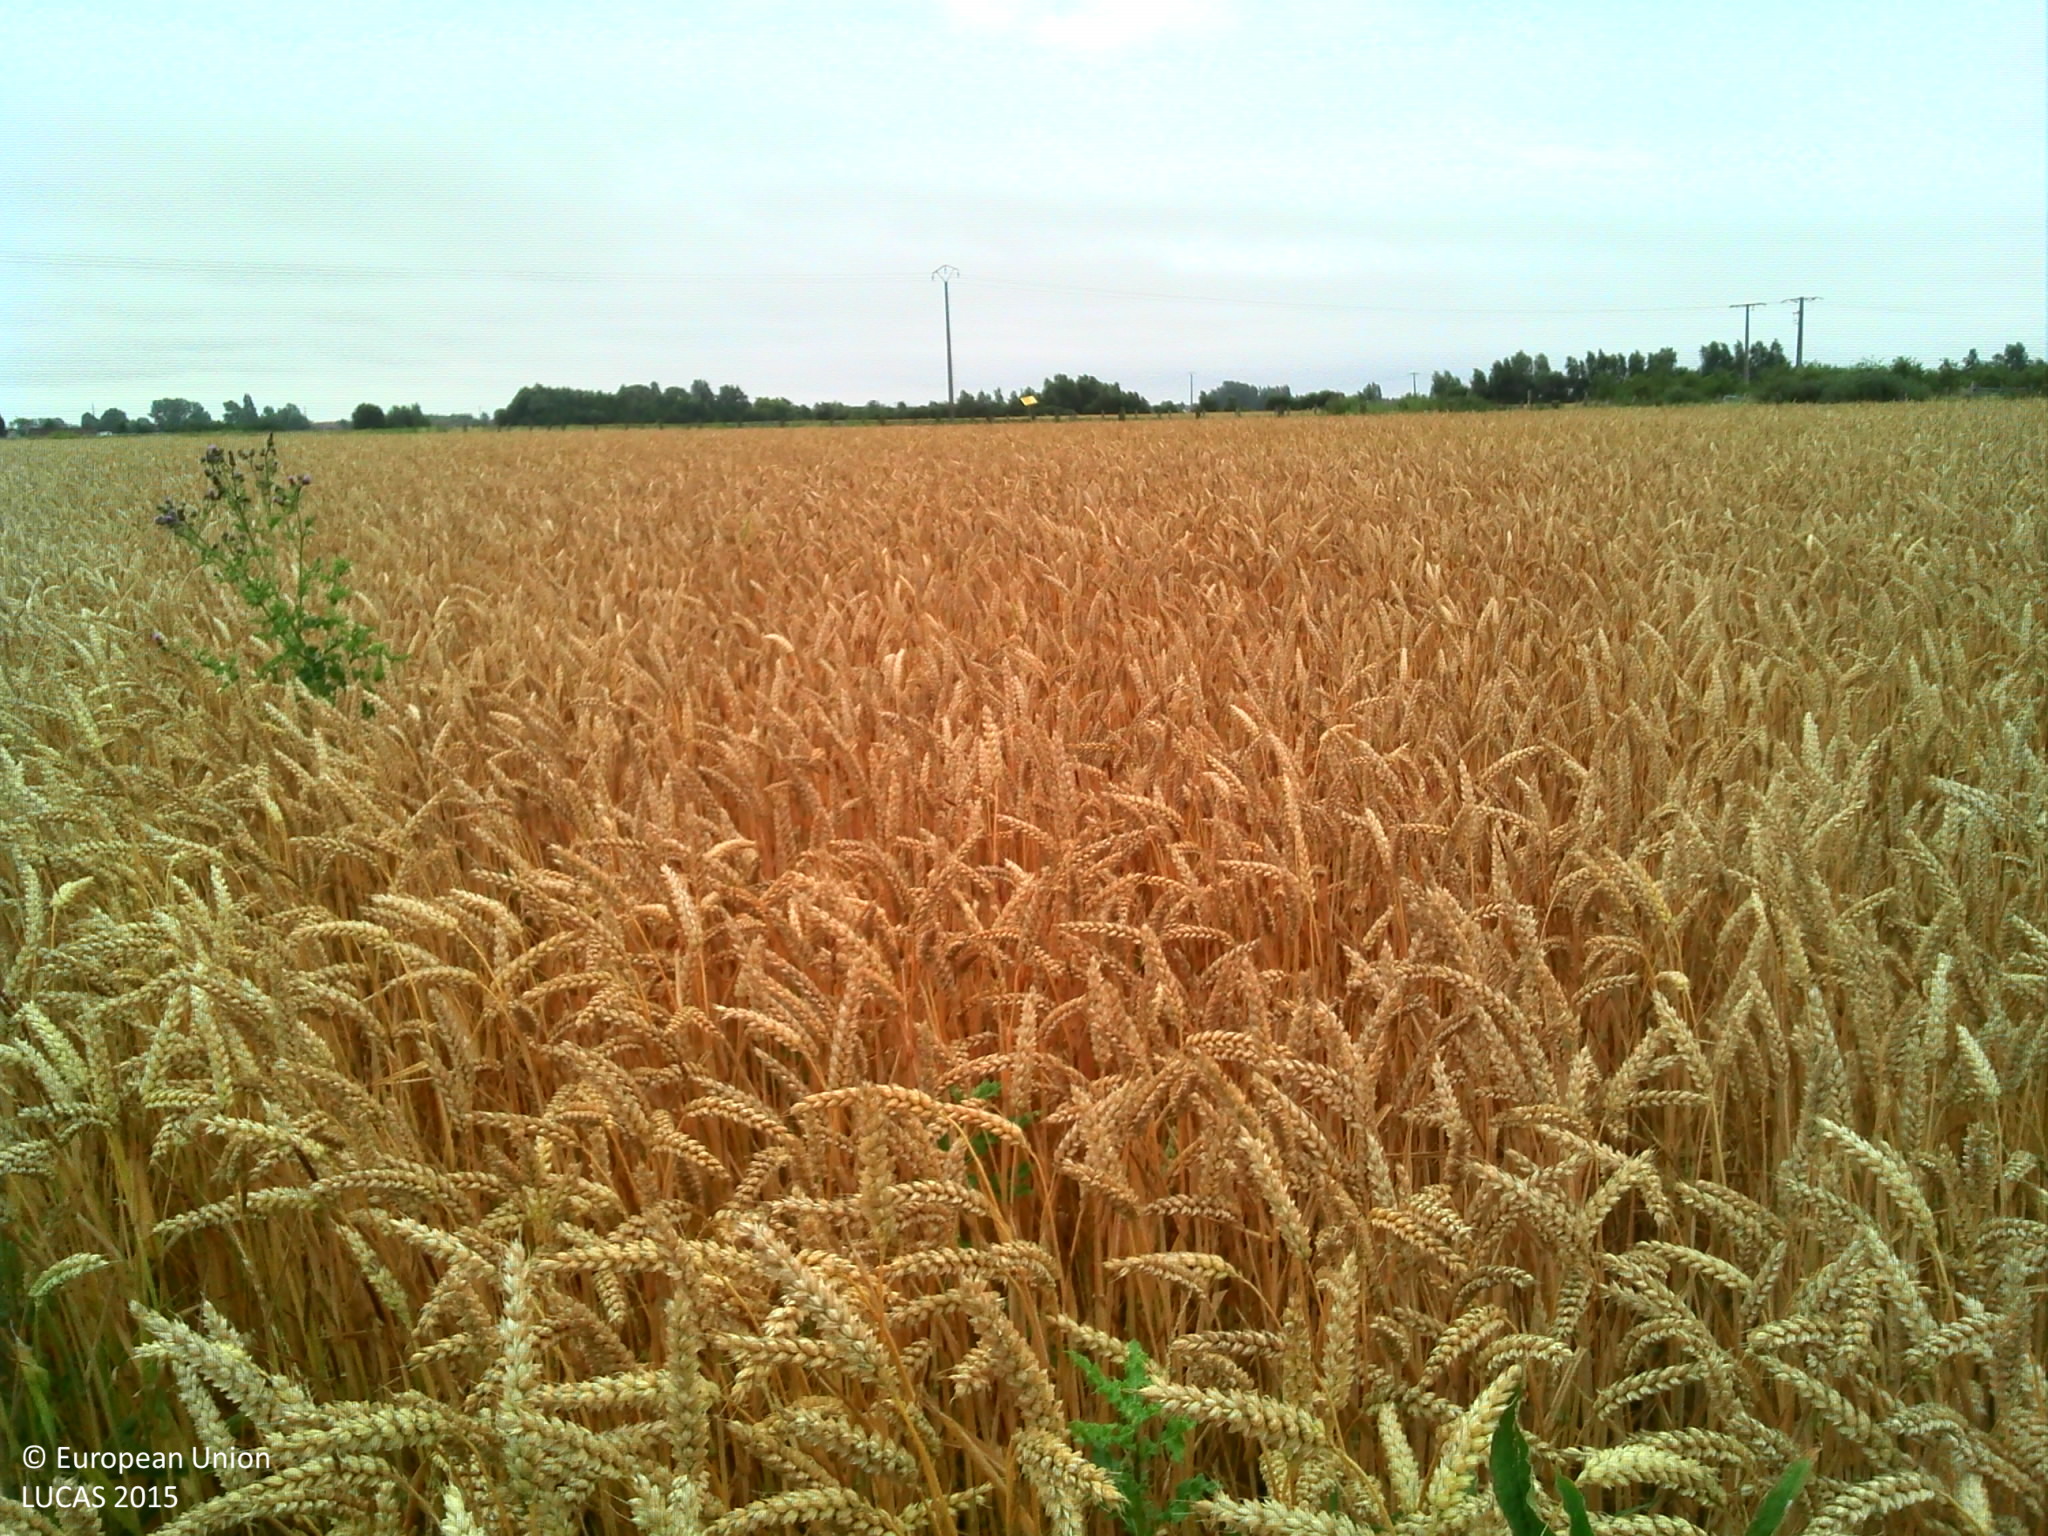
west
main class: Cropland
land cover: Common wheat
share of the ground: > 75 %
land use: Agriculture (excluding fallow land and kitchen gardens)
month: July
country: FR
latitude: 50.9701
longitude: 2.2818
